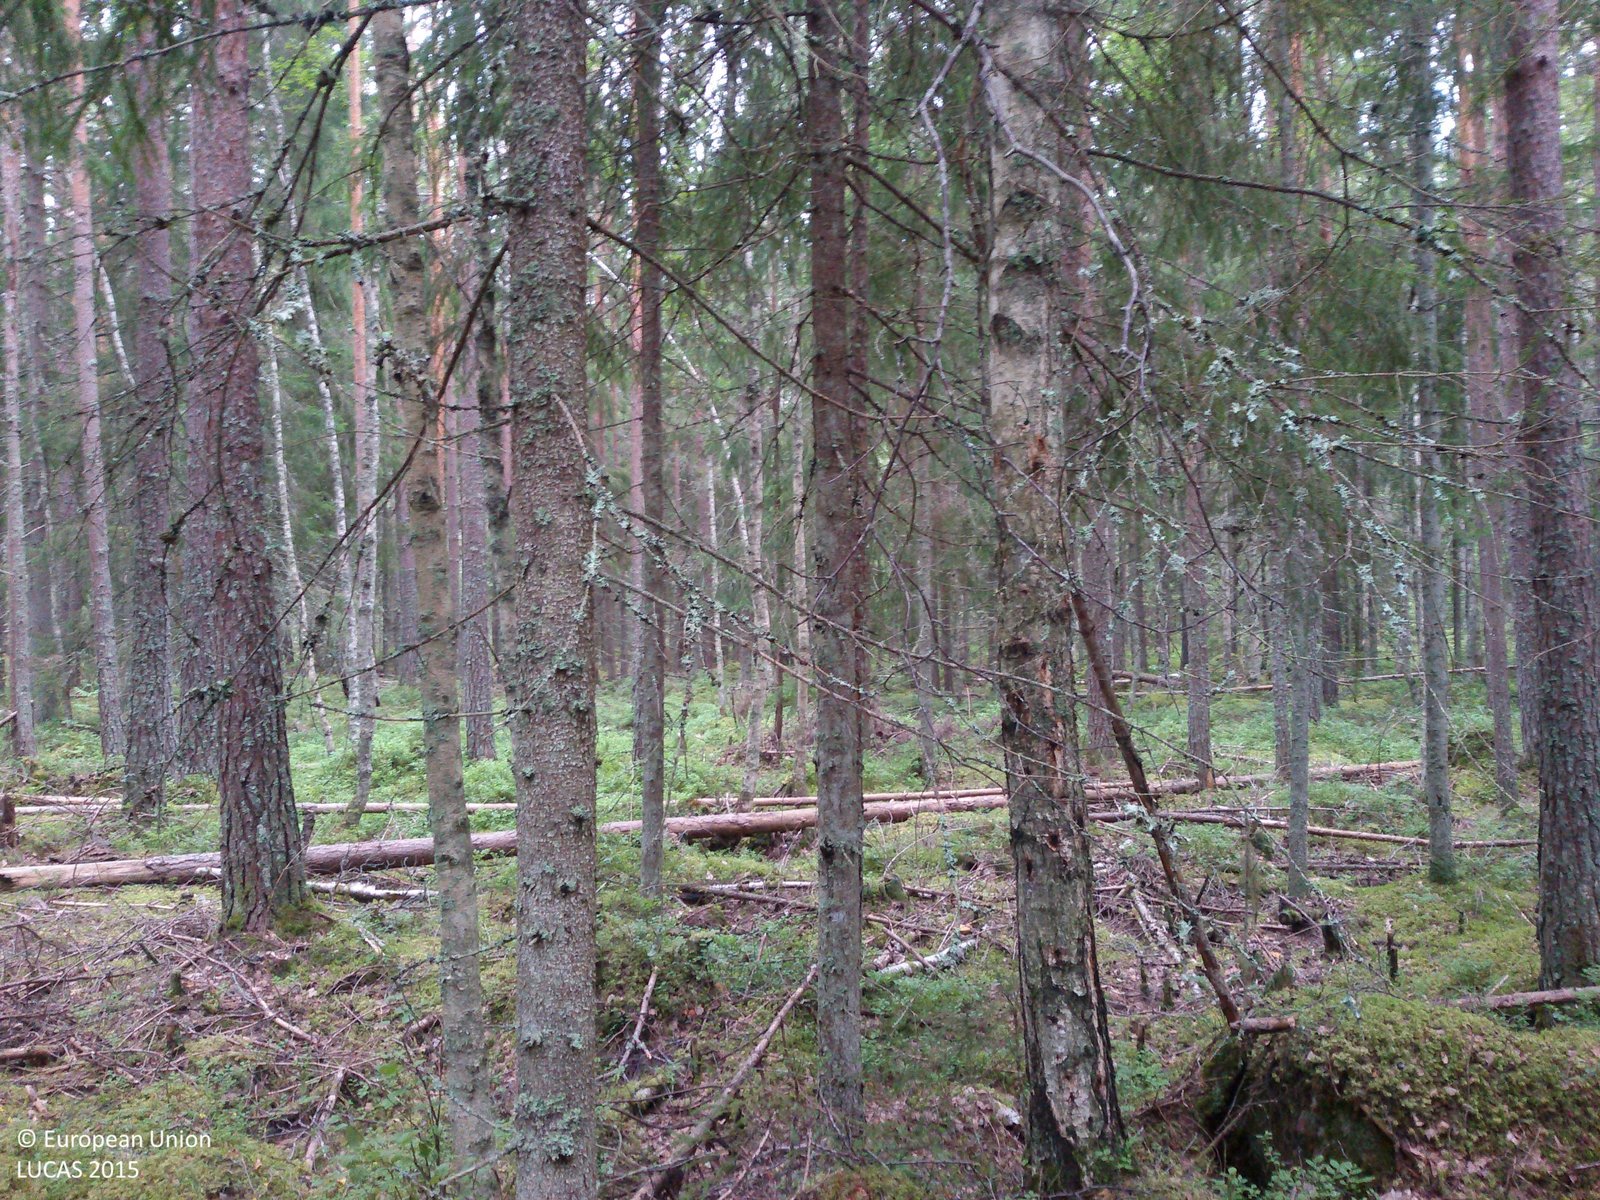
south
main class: Woodland
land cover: Spruce dominated mixed woodland
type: boreal forest
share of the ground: > 75 %
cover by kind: coniferous forest trees 55 %, broadleaved forest trees 30 %, lichens and mosses 10 %, herbaceous plants 5 %
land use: Forestry
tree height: > 5 m
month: August
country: SE
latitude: 60.6574
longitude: 16.6289
